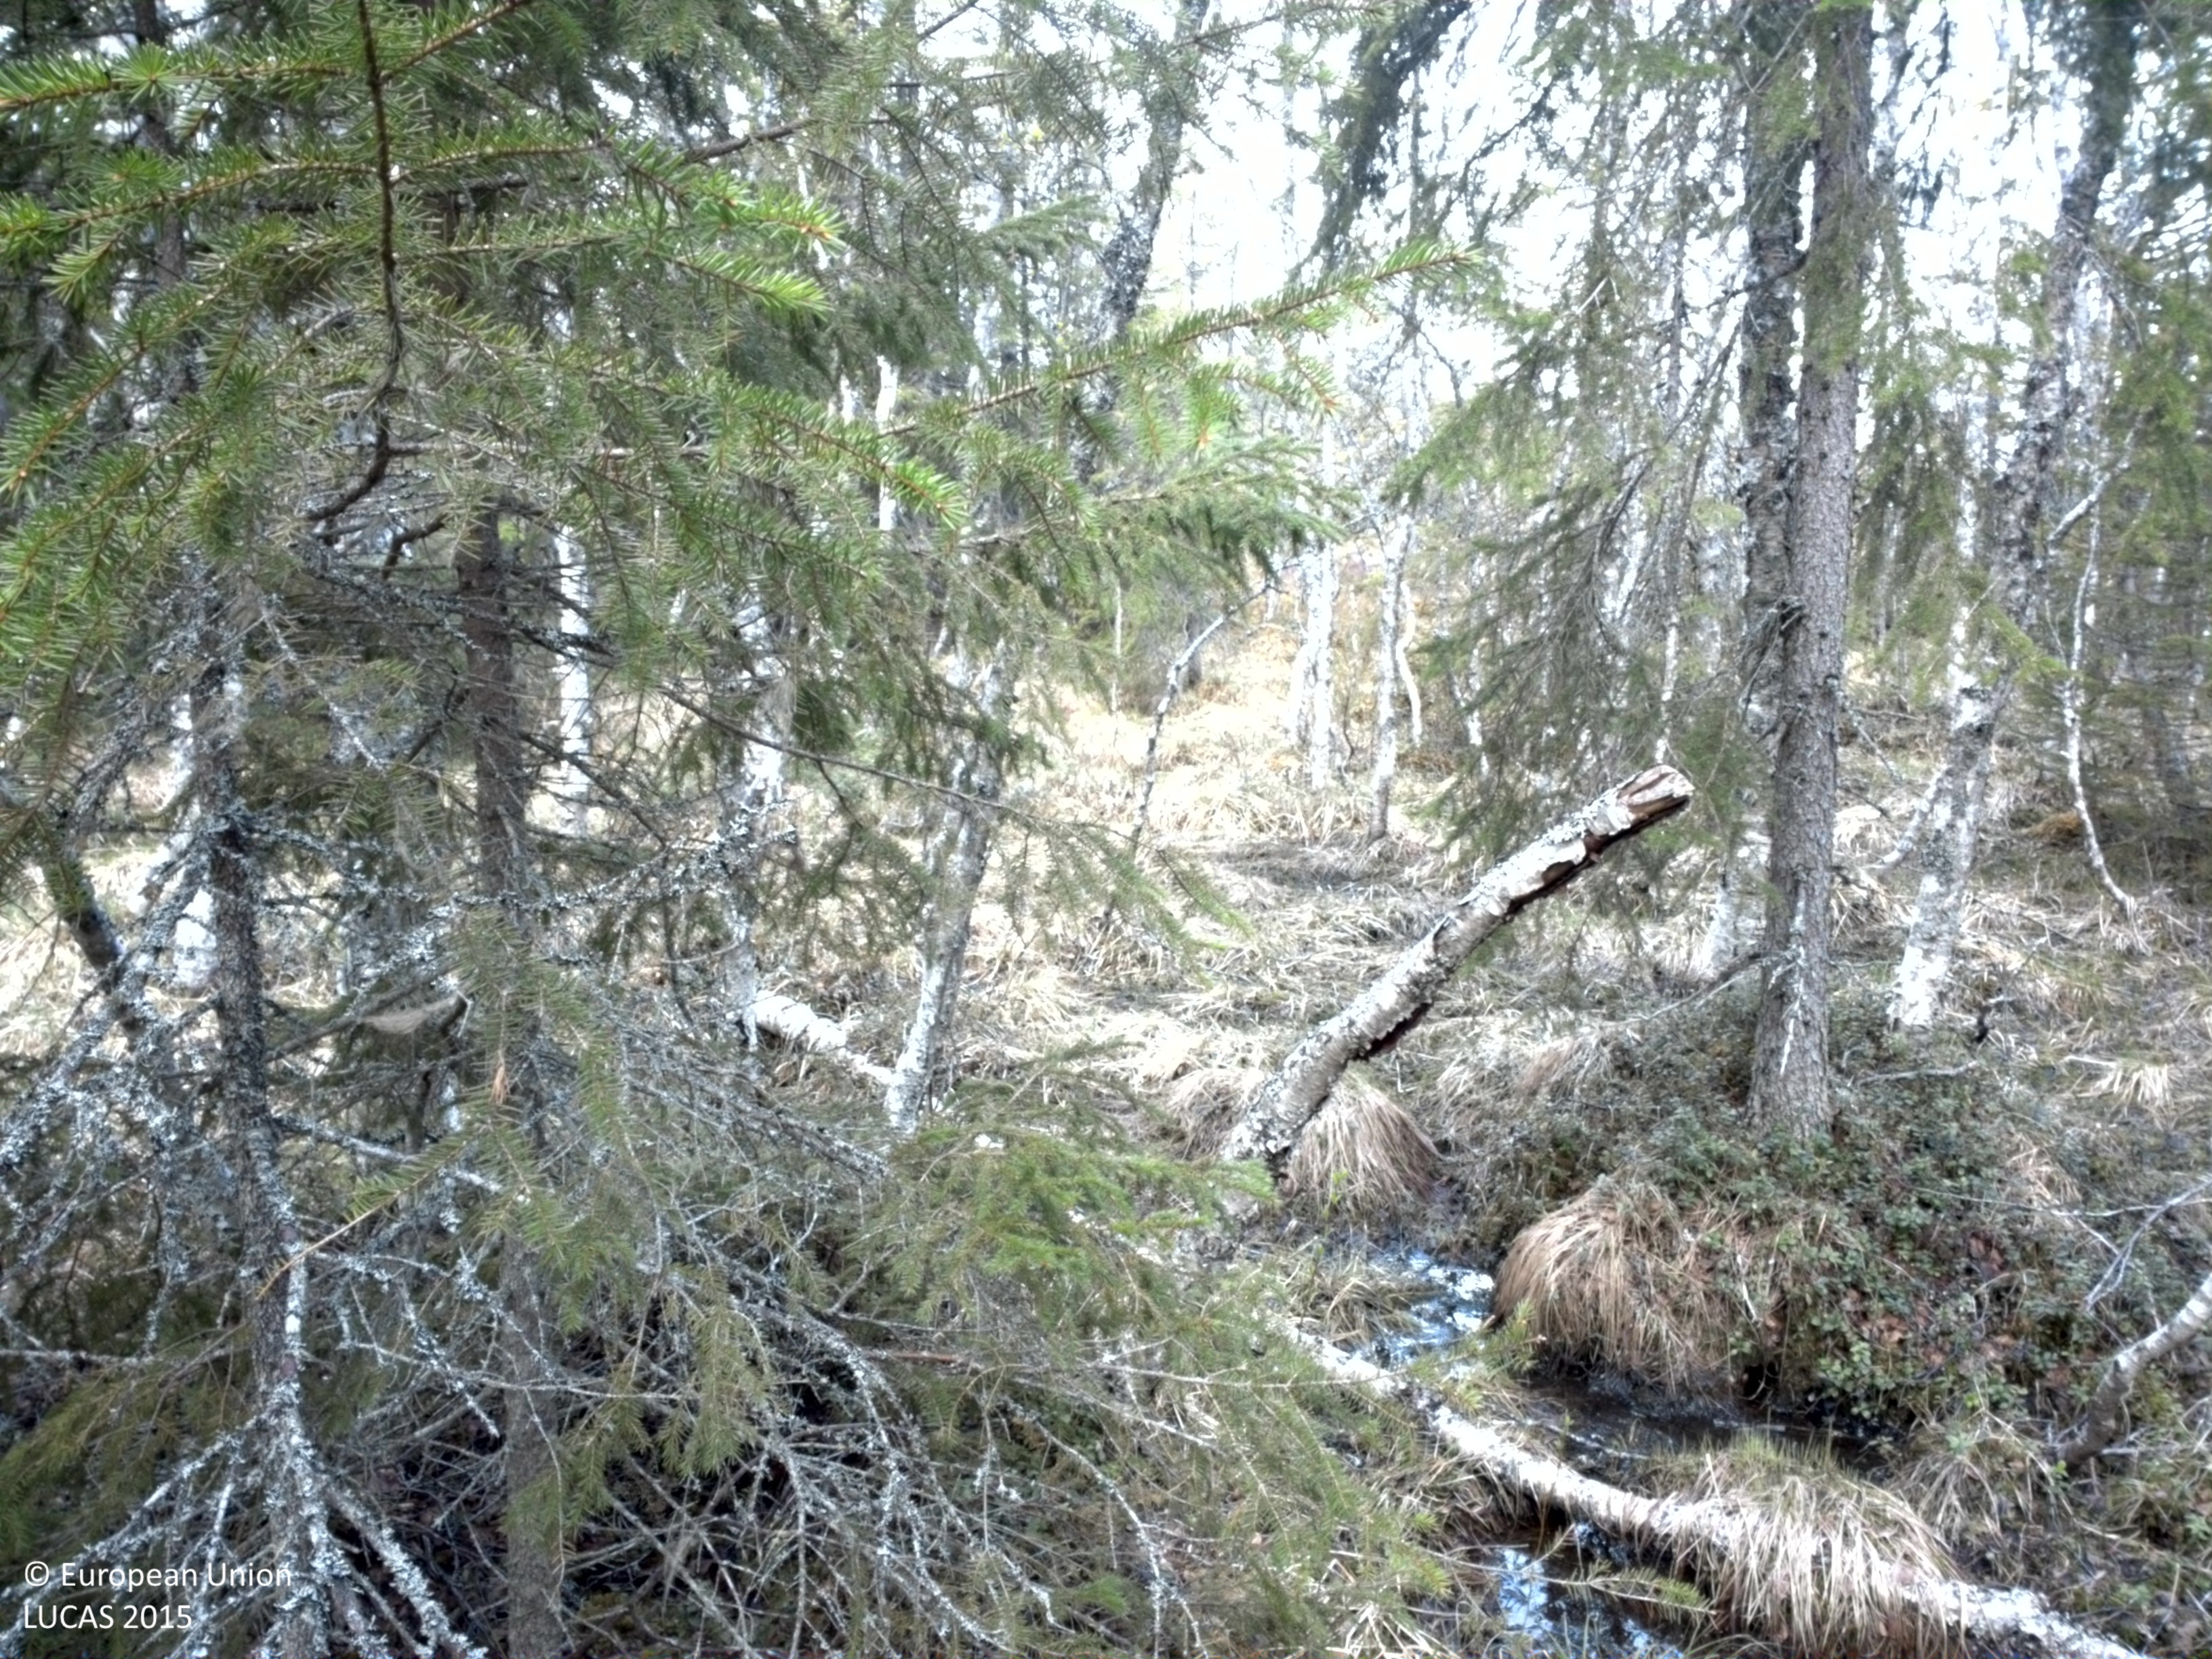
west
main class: Woodland
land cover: Spruce dominated mixed woodland
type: boreal forest
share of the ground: > 75 %
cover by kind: coniferous forest trees 65 %, broadleaved forest trees 25 %, shrubs 10 %
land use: Forestry
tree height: > 5 m
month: June
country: SE
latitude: 63.5218
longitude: 13.7799
